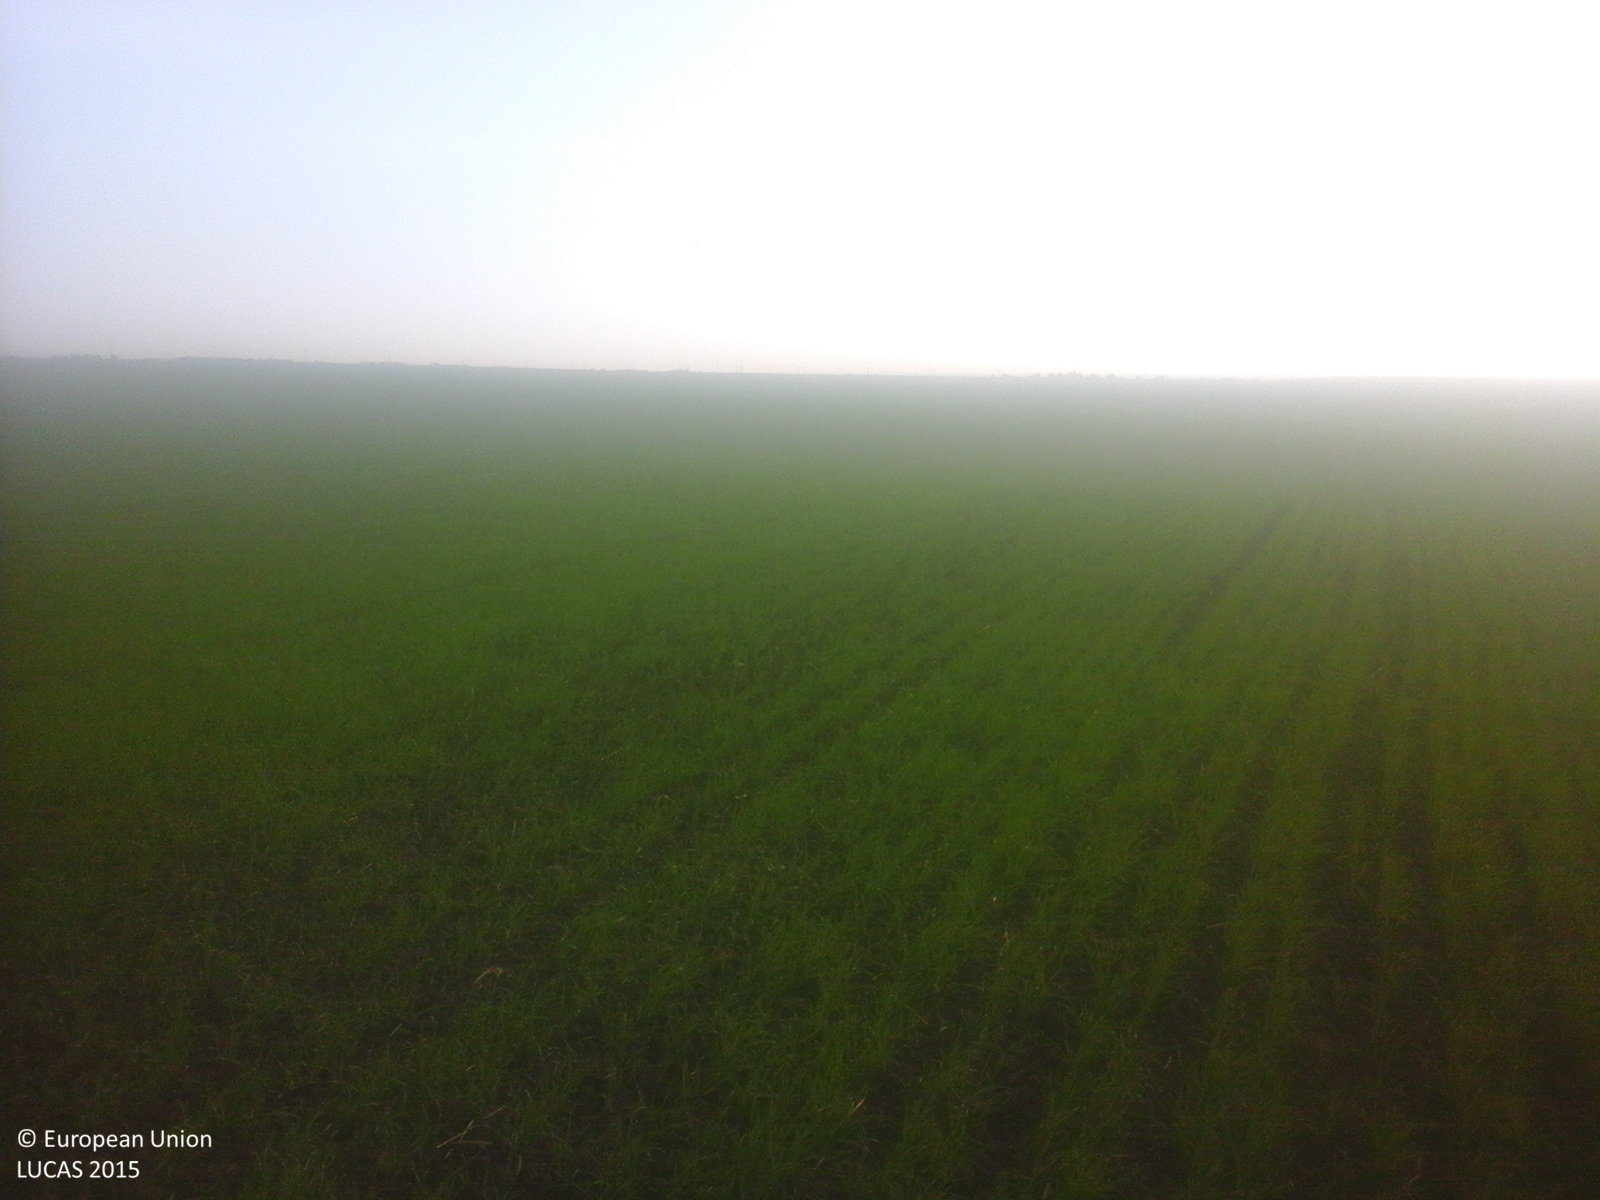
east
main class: Cropland
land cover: Common wheat
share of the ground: 50 - 75 %
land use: Agriculture (excluding fallow land and kitchen gardens)
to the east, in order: Common wheat
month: October
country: RO
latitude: 45.4250
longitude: 27.0749
